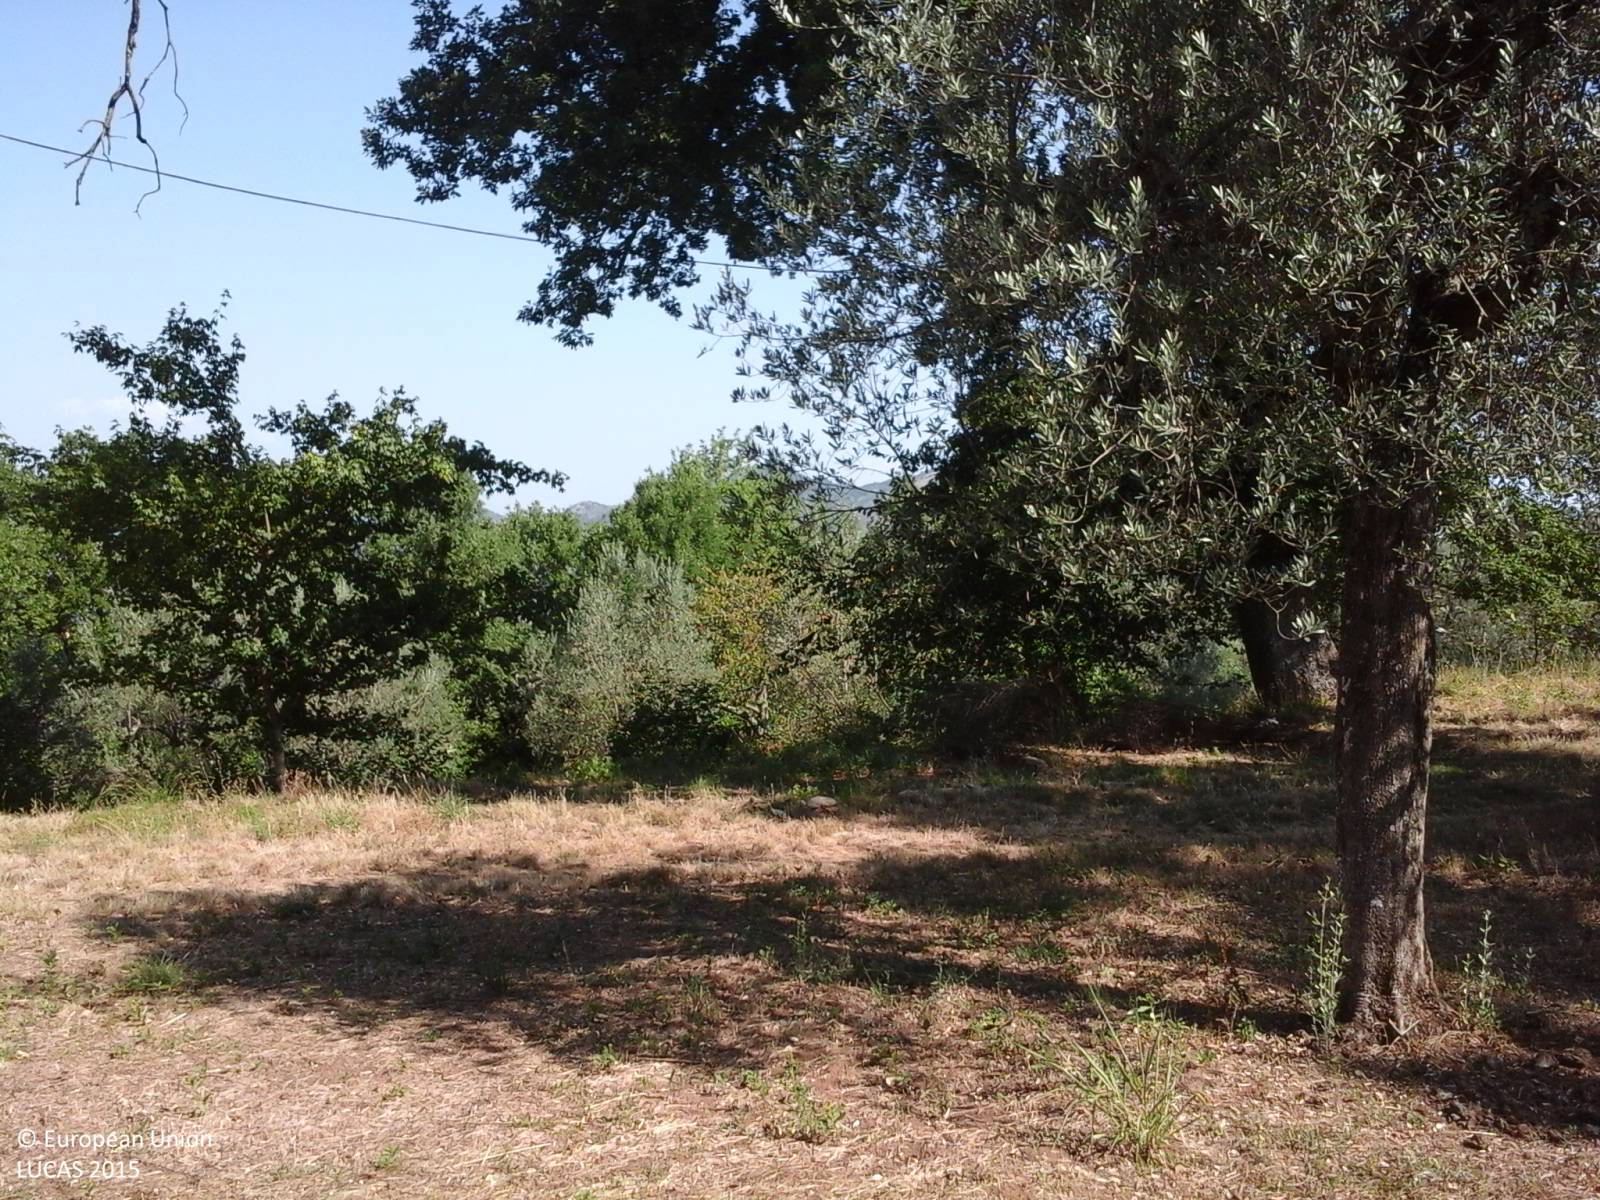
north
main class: Grassland
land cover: Spontaneously vegetated surfaces
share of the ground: > 75 %
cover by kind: herbaceous plants 100 %
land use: Fallow land
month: August
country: IT
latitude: 41.3292
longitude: 13.9396
